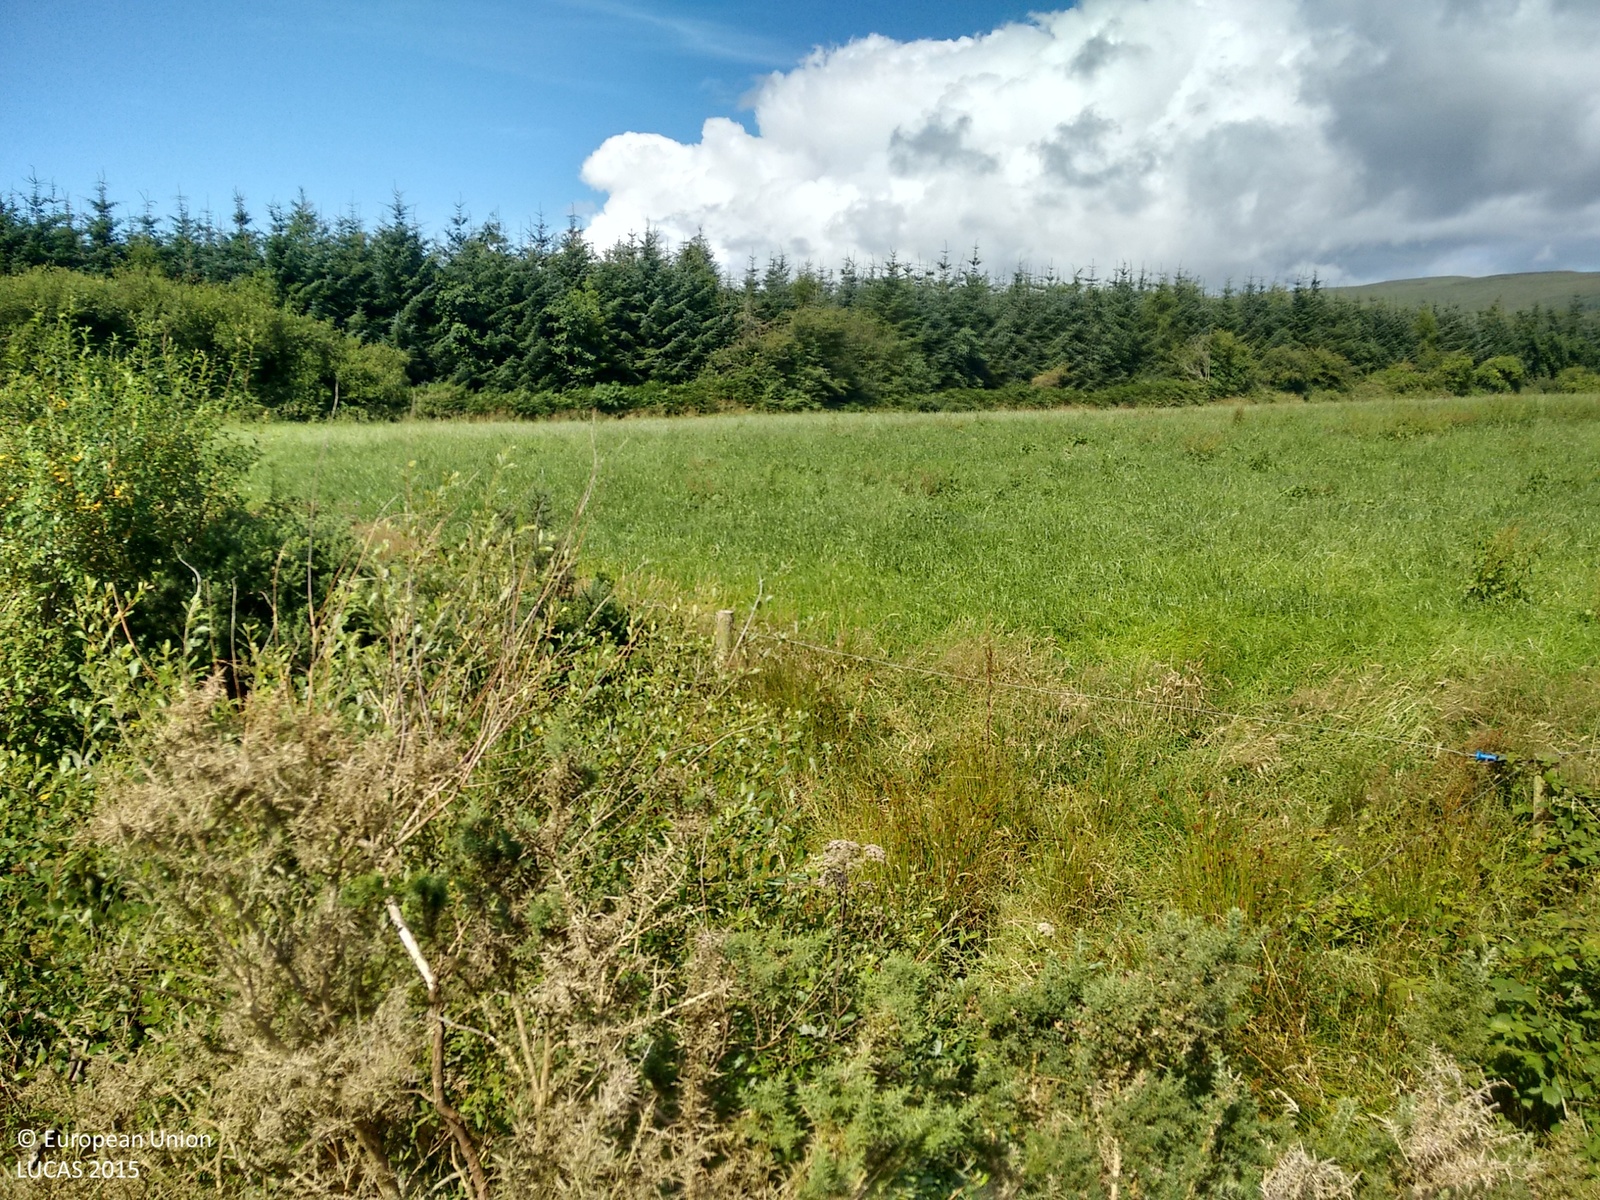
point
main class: Grassland
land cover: Grassland without tree/shrub cover
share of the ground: > 75 %
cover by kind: herbaceous plants 100 %
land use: Agriculture (excluding fallow land and kitchen gardens)
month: August
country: IE
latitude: 52.1932
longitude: -9.6521
